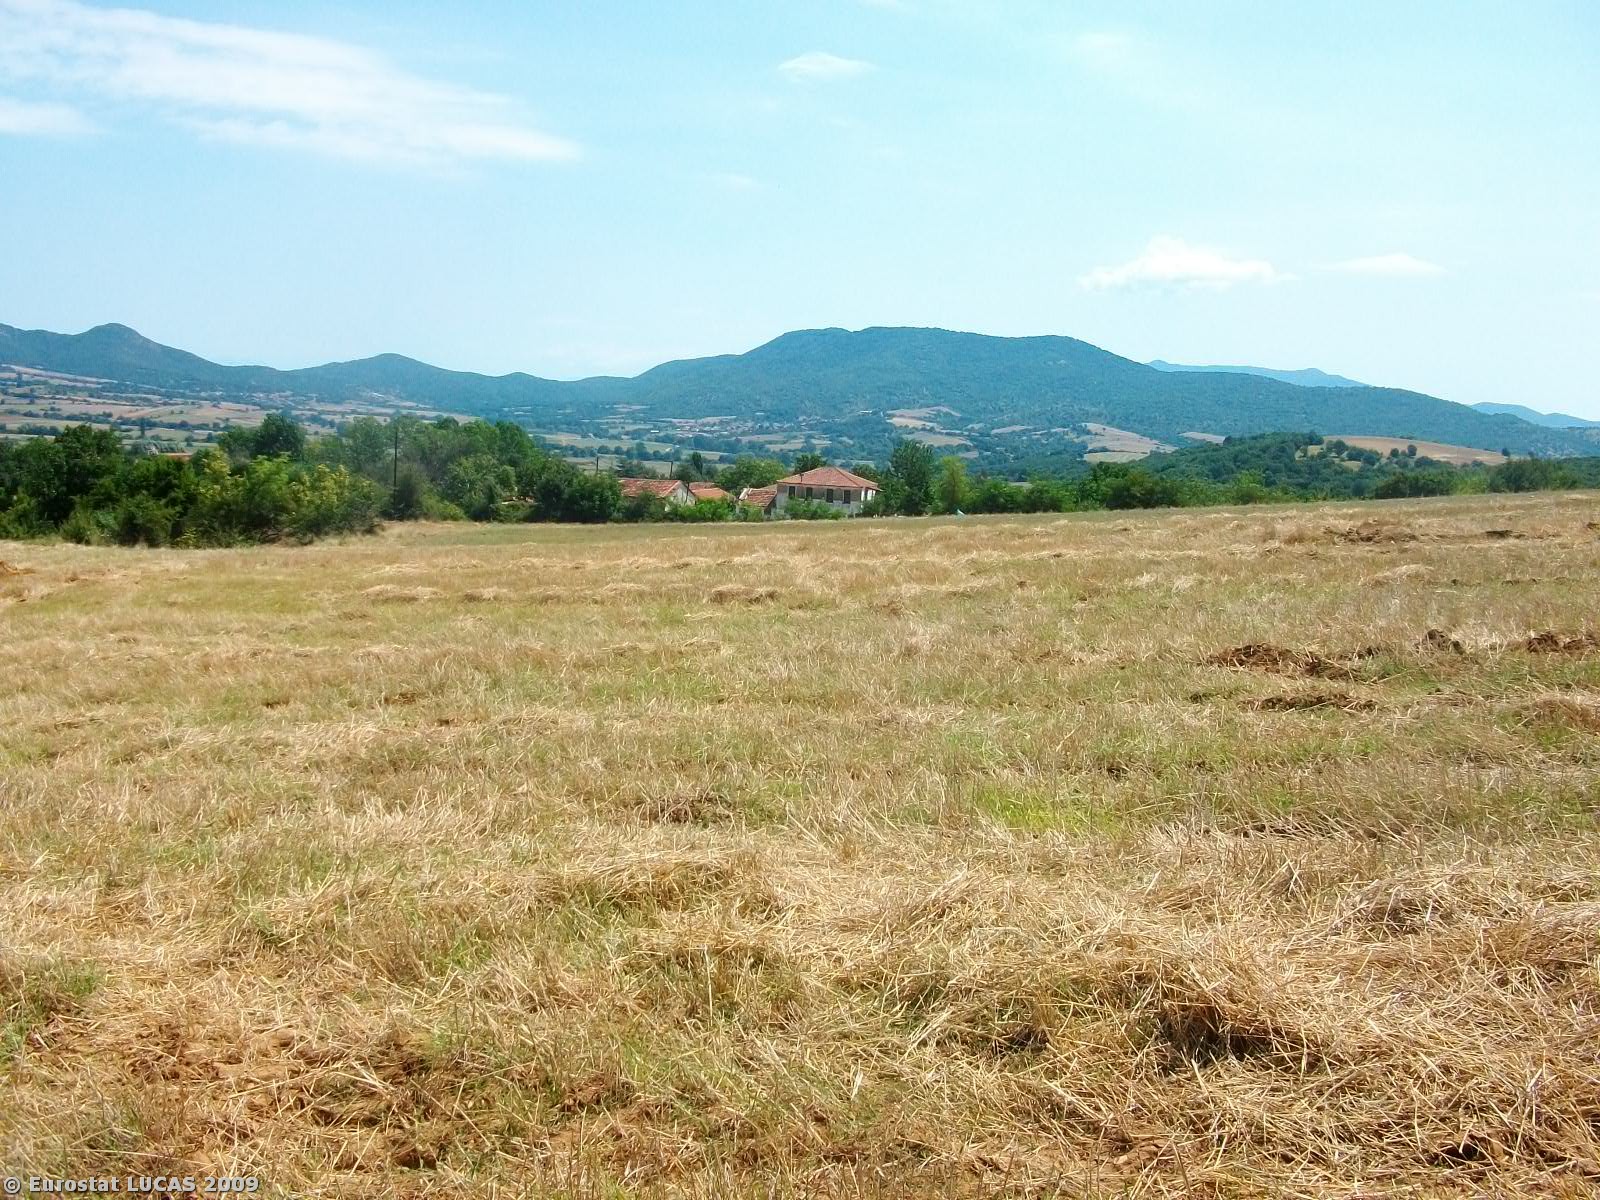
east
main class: Cropland
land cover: Barley
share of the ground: < 10 %
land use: Agriculture (excluding fallow land and kitchen gardens)
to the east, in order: Barley; Spontaneously vegetated surfaces; Barley; Abandoned hedges; Fences; Spontaneously vegetated surfaces; Artificial constructions in urban areas; Spontaneously vegetated surfaces; Fences; Other fresh vegetables; Single bushes/trees; Bare land; Electric lines; Grass margins
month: July
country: GR
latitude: 41.1409
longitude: 22.9635
